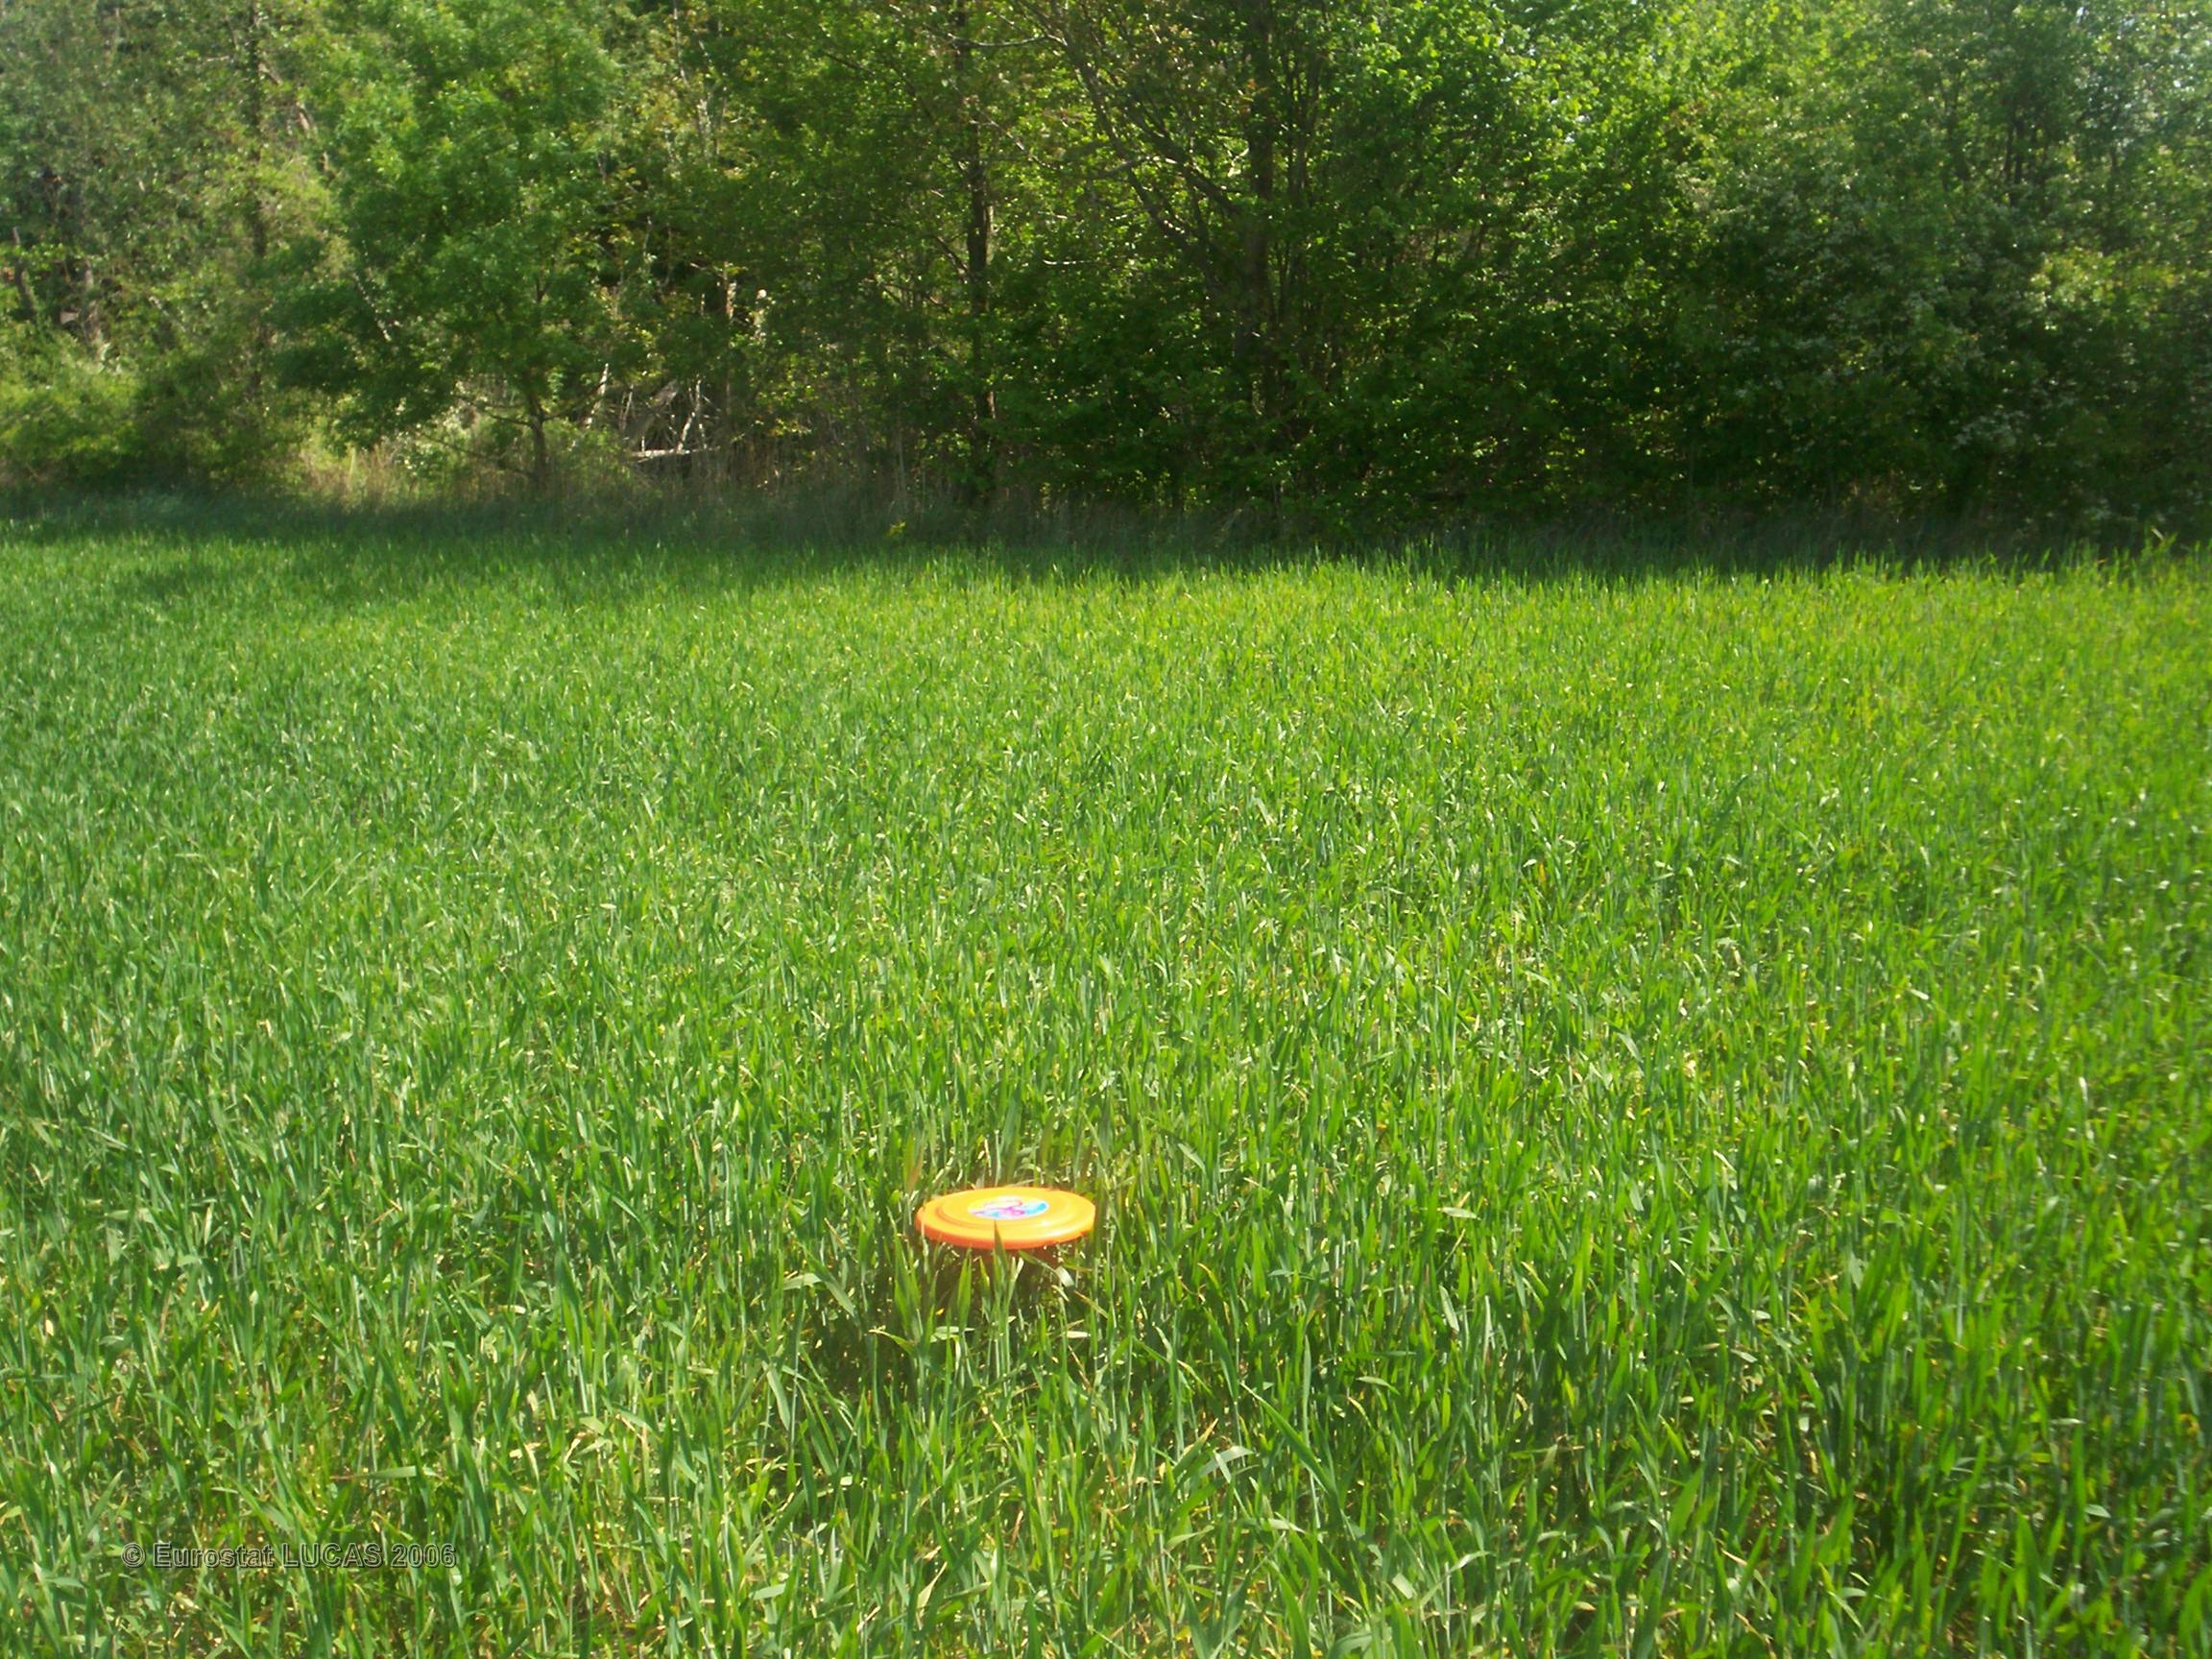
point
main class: Cropland
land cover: Durum wheat
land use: Agriculture (excluding fallow land and kitchen gardens)
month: April
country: FR
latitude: 43.9763
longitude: 4.9847
